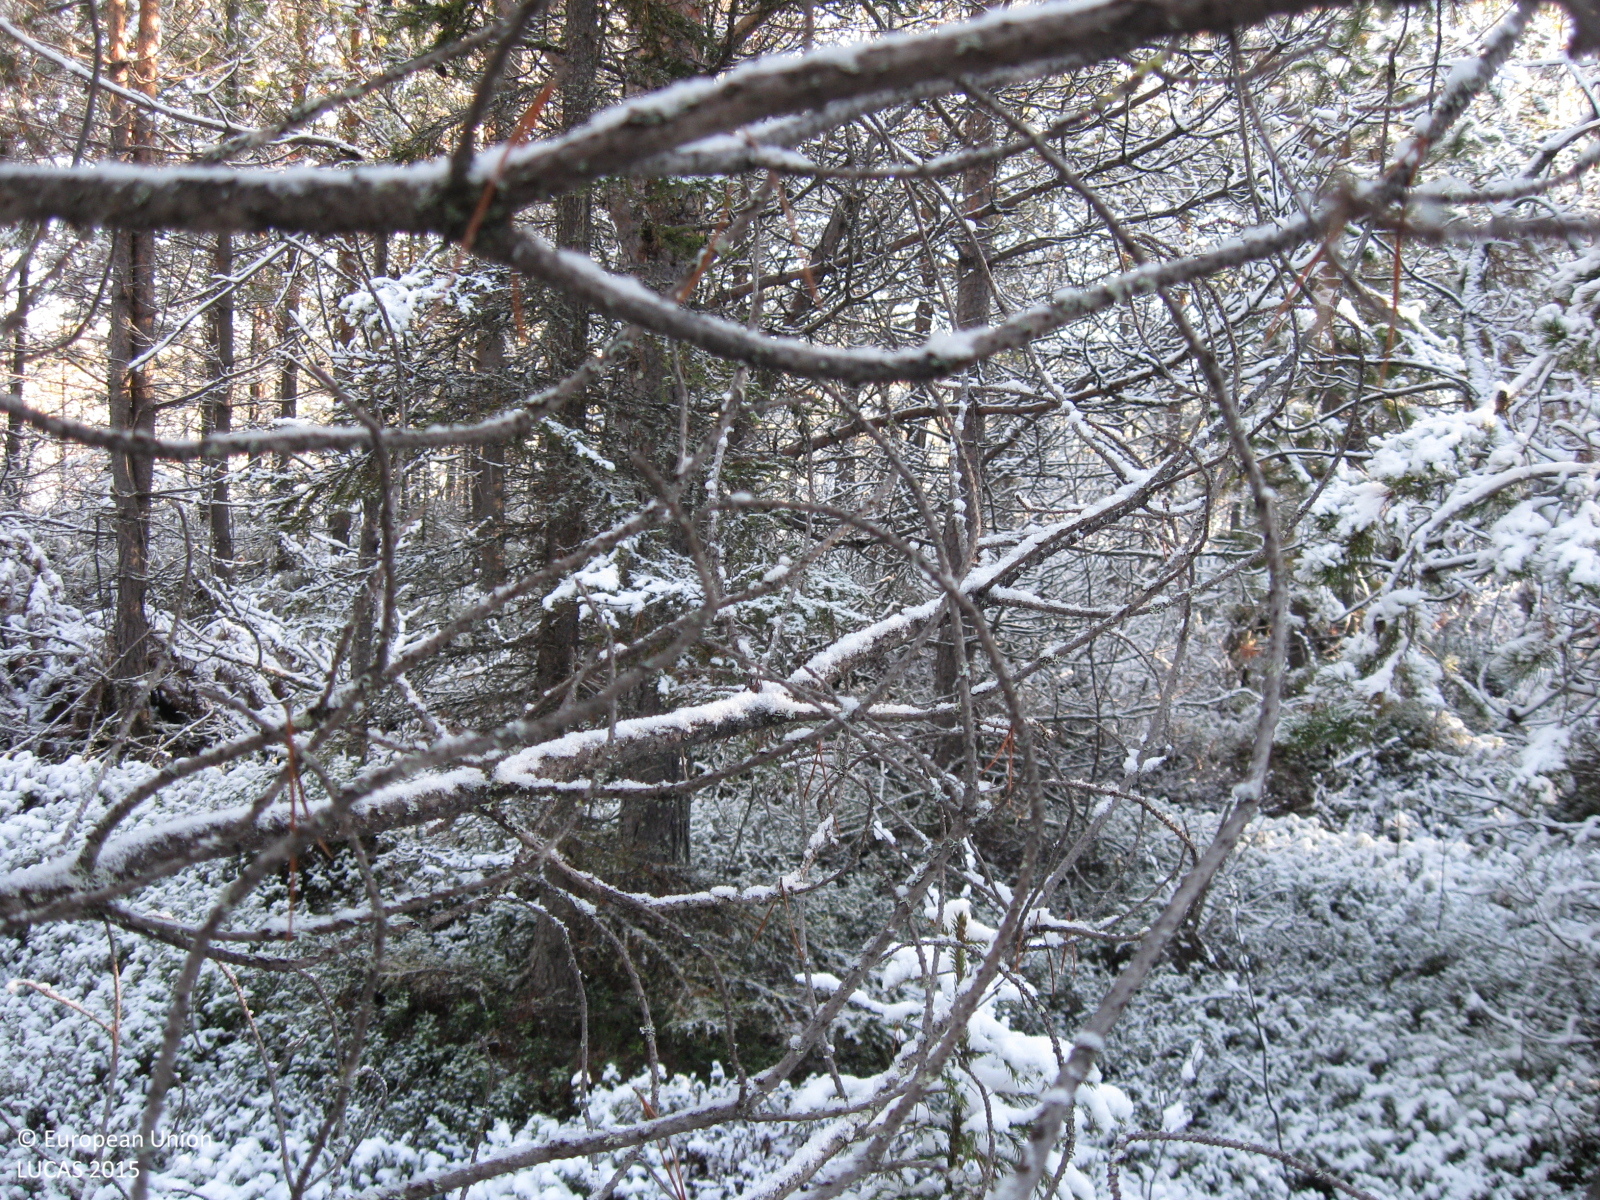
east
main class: Woodland
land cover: Pine dominated coniferous woodland
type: mire and swamp forests
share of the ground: > 75 %
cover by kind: coniferous forest trees 90 %, broadleaved forest trees 5 %, shrubs 5 %
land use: Forestry
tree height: > 5 m
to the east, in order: Pine dominated coniferous woodland; Peatbogs; Pine dominated coniferous woodland; Peatbogs; Shrubland with sparse tree cover; Broadleaved woodland; Rivers and streams; Broadleaved woodland
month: October
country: SE
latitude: 66.4023
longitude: 21.4024
